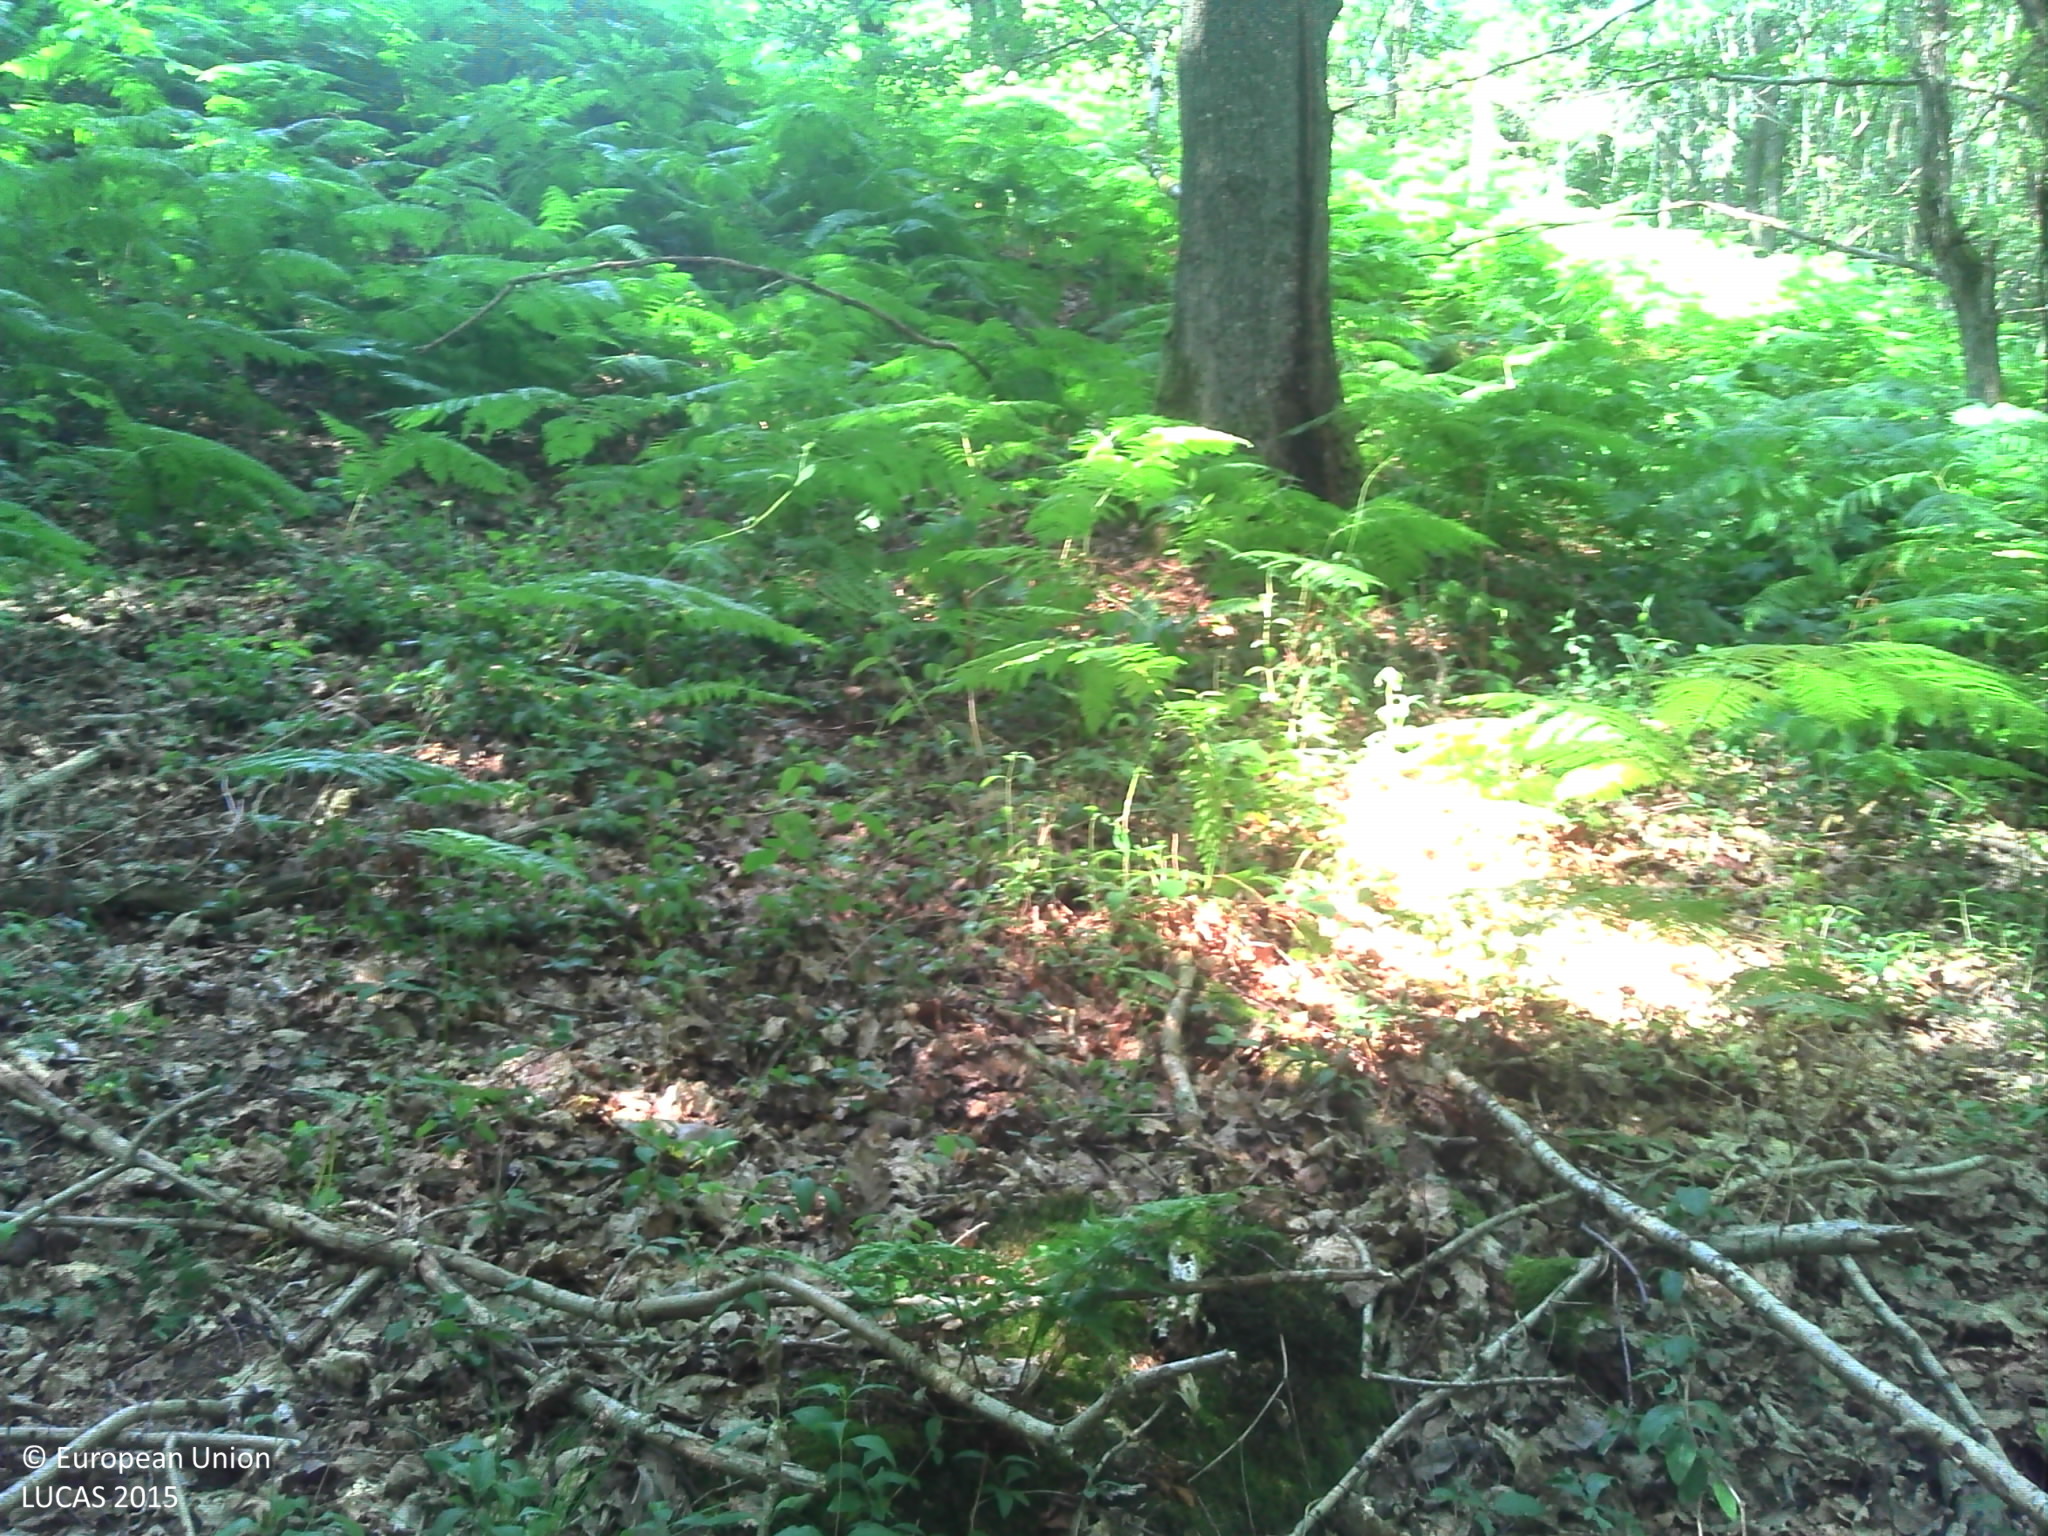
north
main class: Woodland
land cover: Broadleaved woodland
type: mesophytic deciduous forest
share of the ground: > 75 %
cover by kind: broadleaved forest trees 90 %, herbaceous plants 5 %, unconsolidated bare surface 5 %
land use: Forestry
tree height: > 5 m
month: July
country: FR
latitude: 49.0667
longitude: 3.2994
